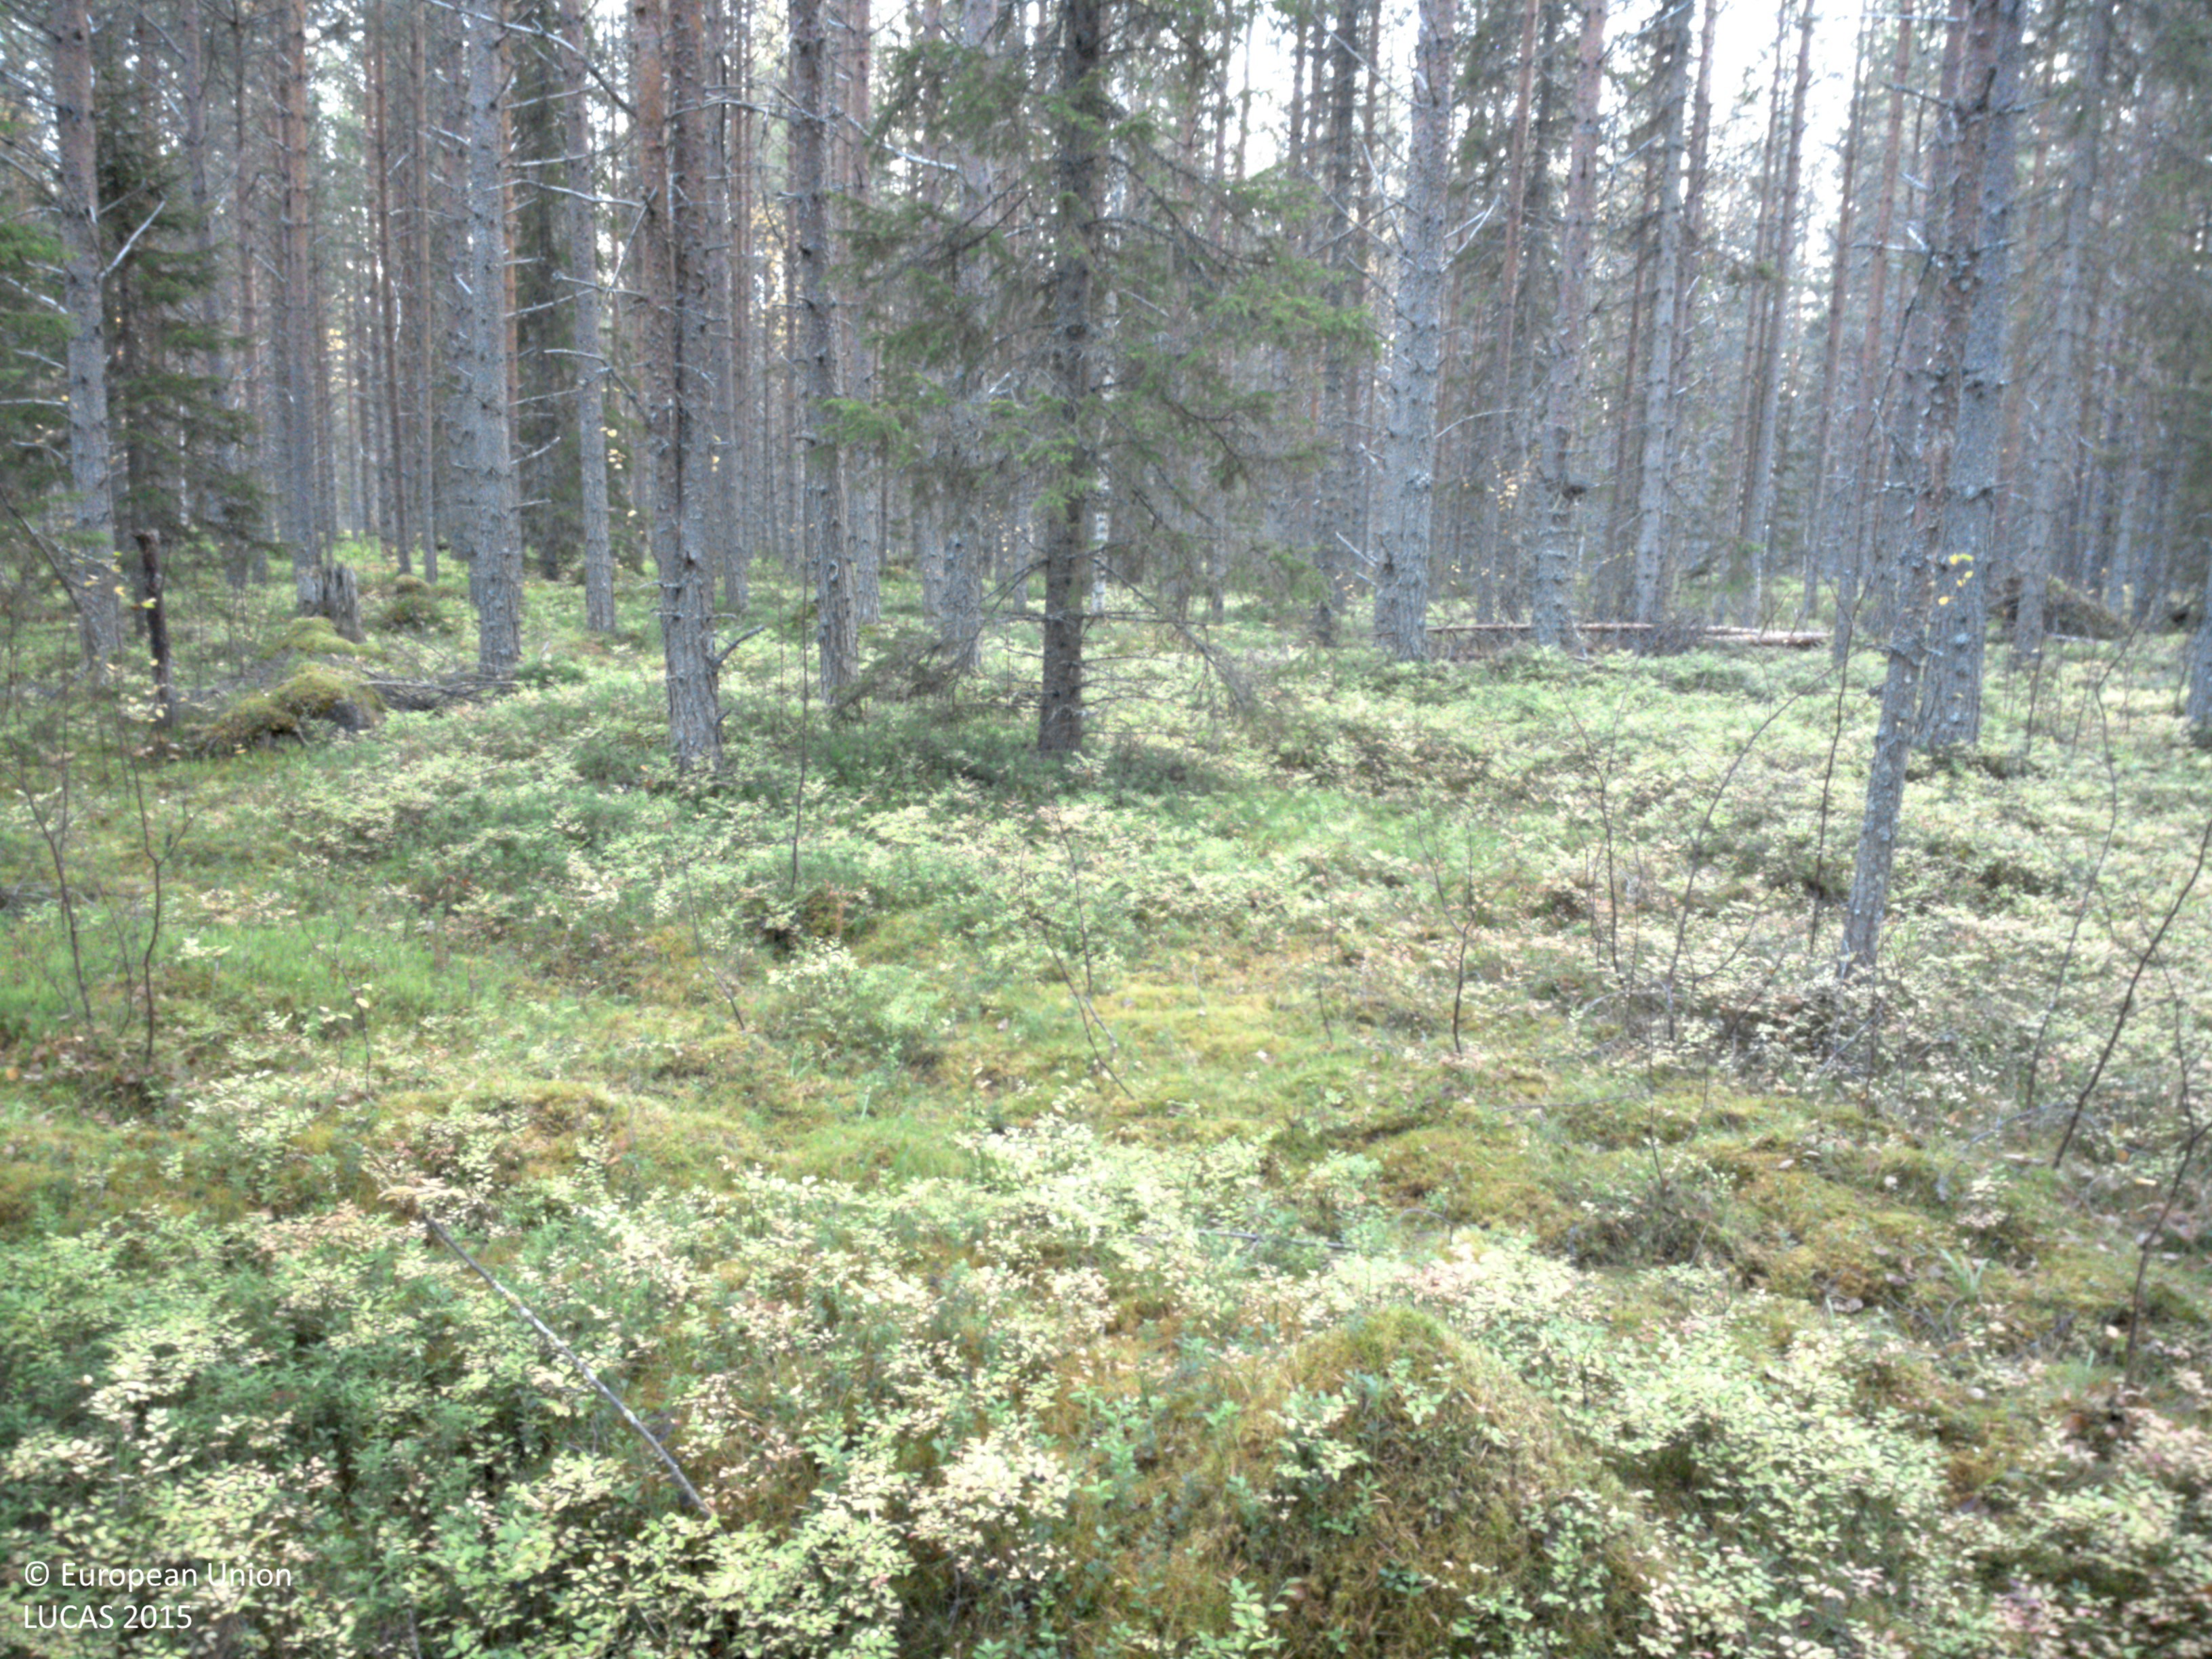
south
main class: Woodland
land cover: Pine dominated mixed woodland
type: boreal forest
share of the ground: 50 - 75 %
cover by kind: coniferous forest trees 45 %, shrubs 35 %, broadleaved forest trees 15 %, lichens and mosses 5 %
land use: Forestry
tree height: > 5 m
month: September
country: SE
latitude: 64.9273
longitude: 18.2762
